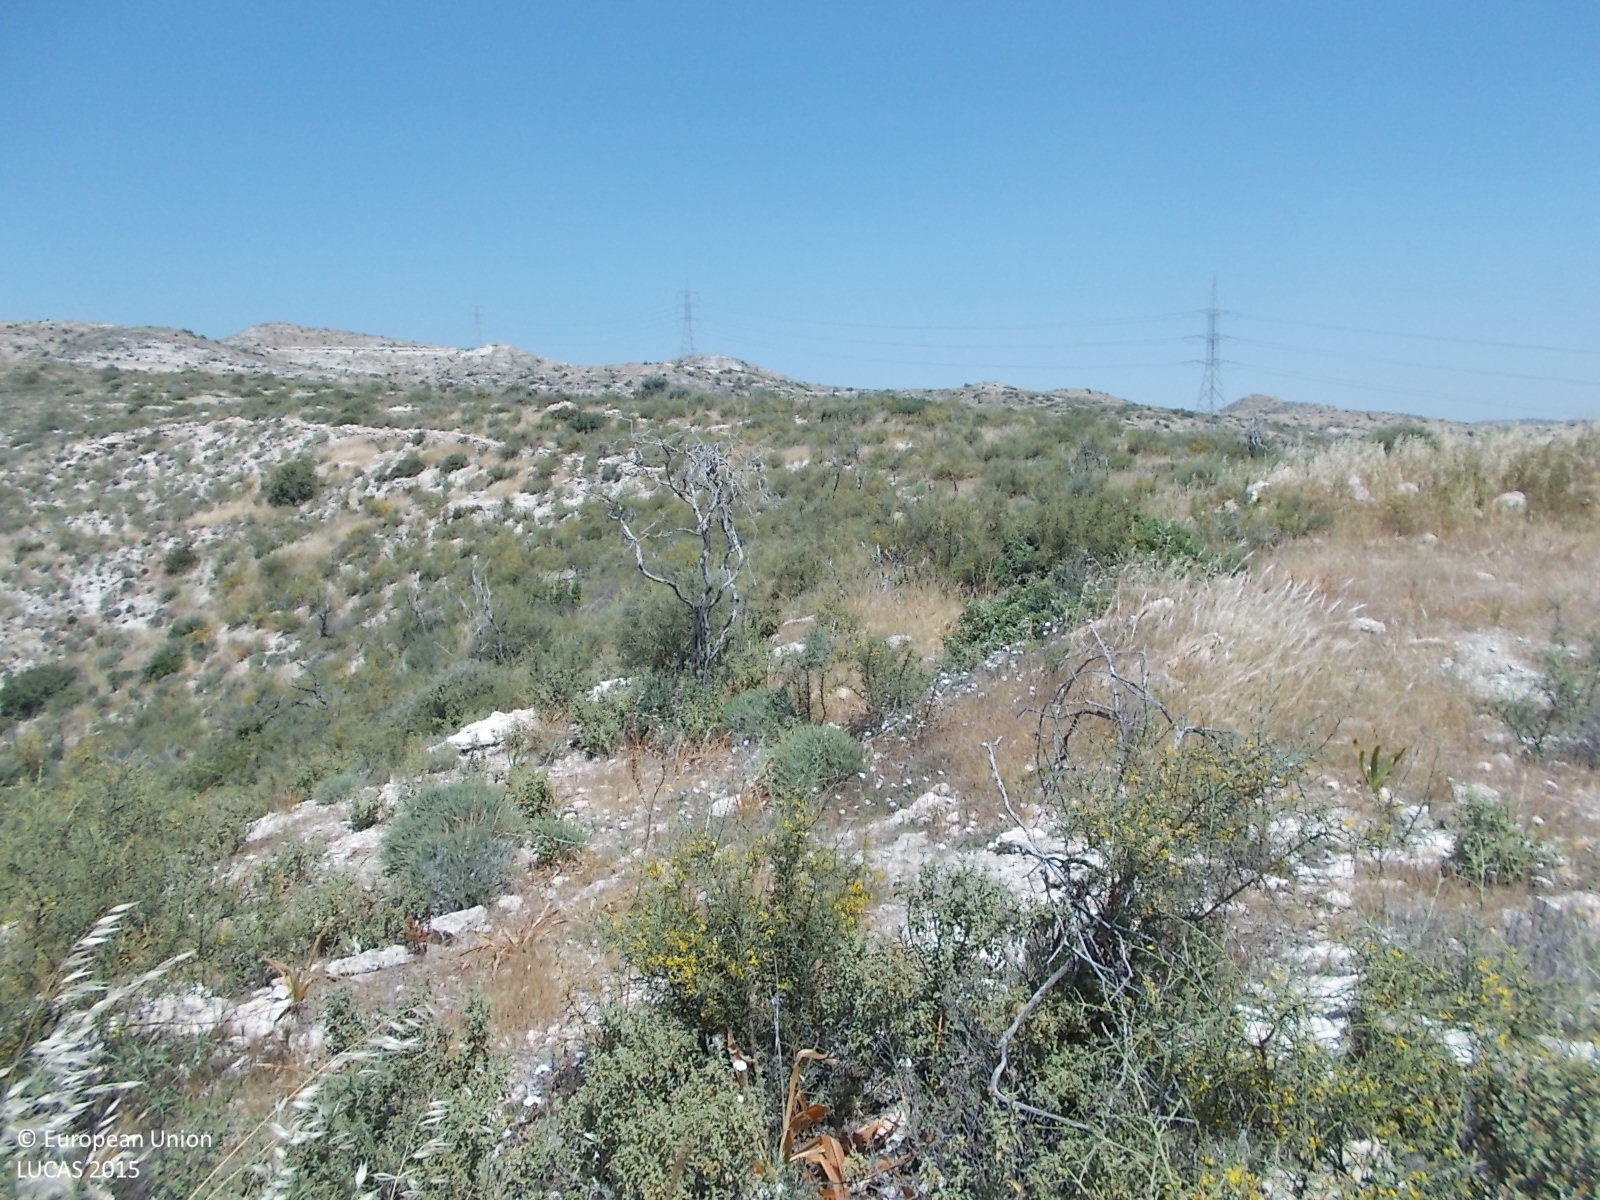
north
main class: Grassland
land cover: Grassland with sparse tree/shrub cover
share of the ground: > 75 %
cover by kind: herbaceous plants 80 %, broadleaved forest trees 5 %, shrubs 5 %, consolidated bare surface 5 %, unconsolidated bare surface 5 %
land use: Semi-natural and natural areas not in use
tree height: < 5 m
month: April
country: CY
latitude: 34.7587
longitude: 33.2828
